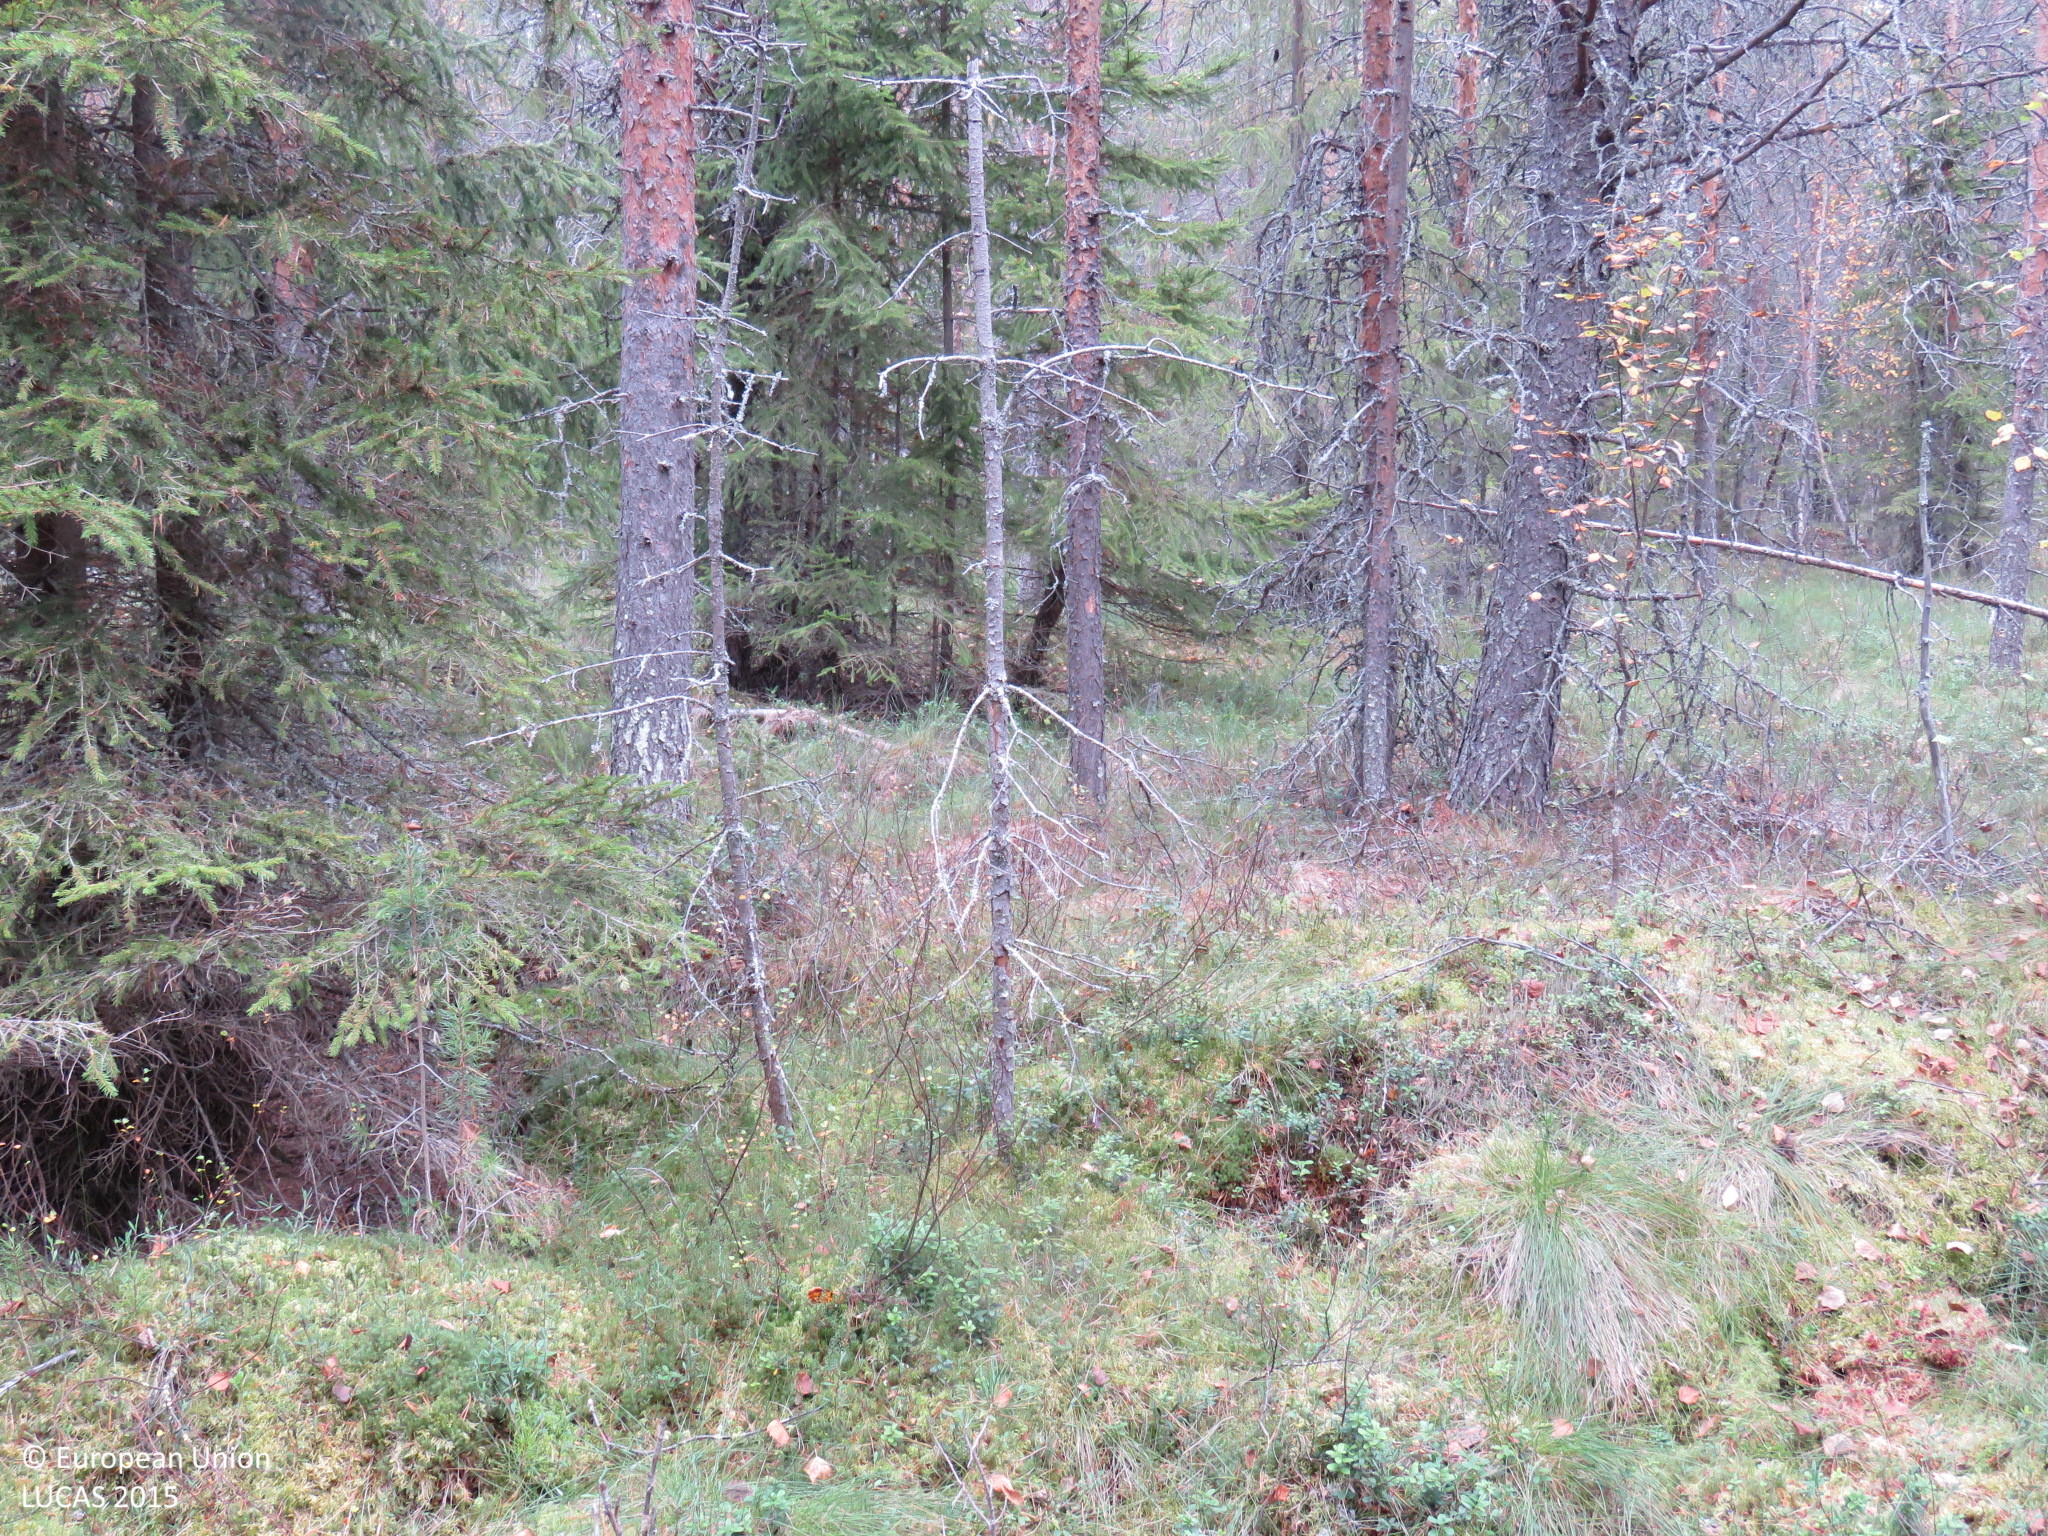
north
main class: Woodland
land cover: Other coniferous woodland
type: mire and swamp forests
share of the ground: > 75 %
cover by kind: coniferous forest trees 60 %, broadleaved forest trees 15 %, shrubs 10 %, herbaceous plants 10 %, lichens and mosses 5 %
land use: Forestry
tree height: > 5 m
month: September
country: FI
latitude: 64.9223
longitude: 26.9748
